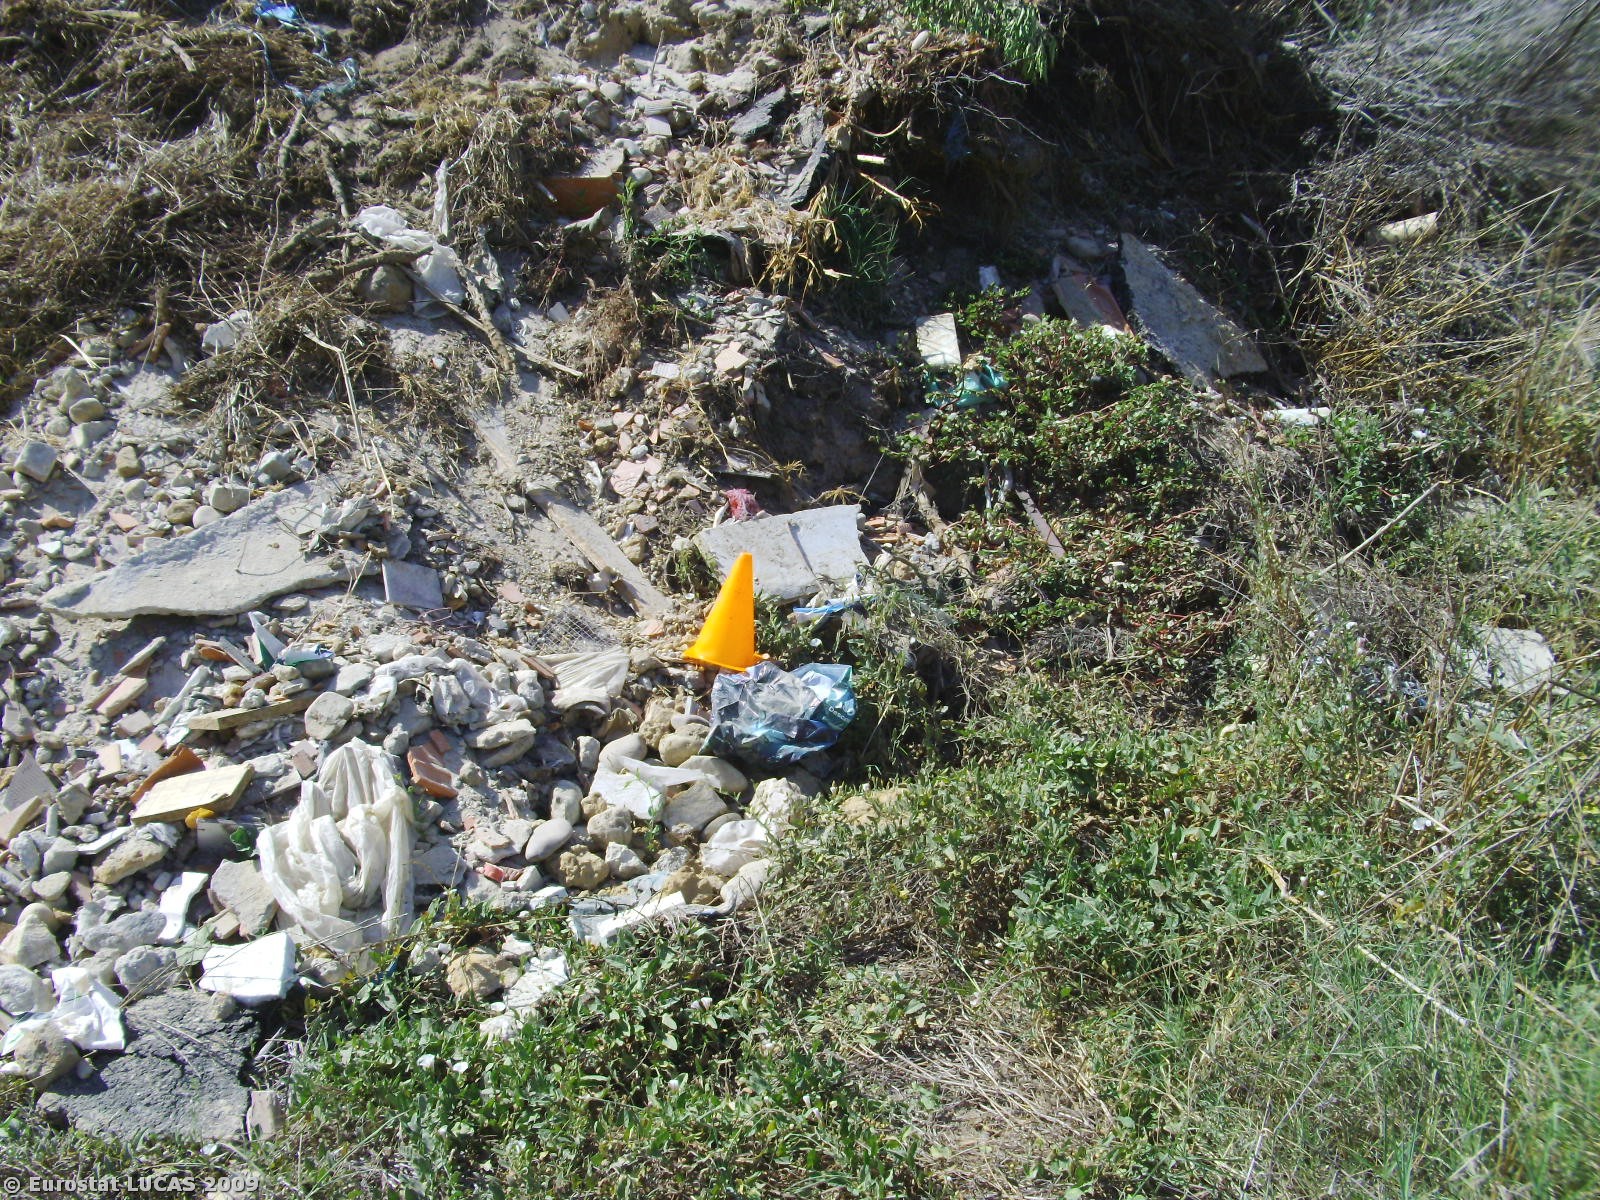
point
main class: Grassland
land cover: Spontaneously vegetated surfaces
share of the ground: 10 - 25 %
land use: Unused
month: July
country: PT
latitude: 38.9767
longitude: -8.7575
